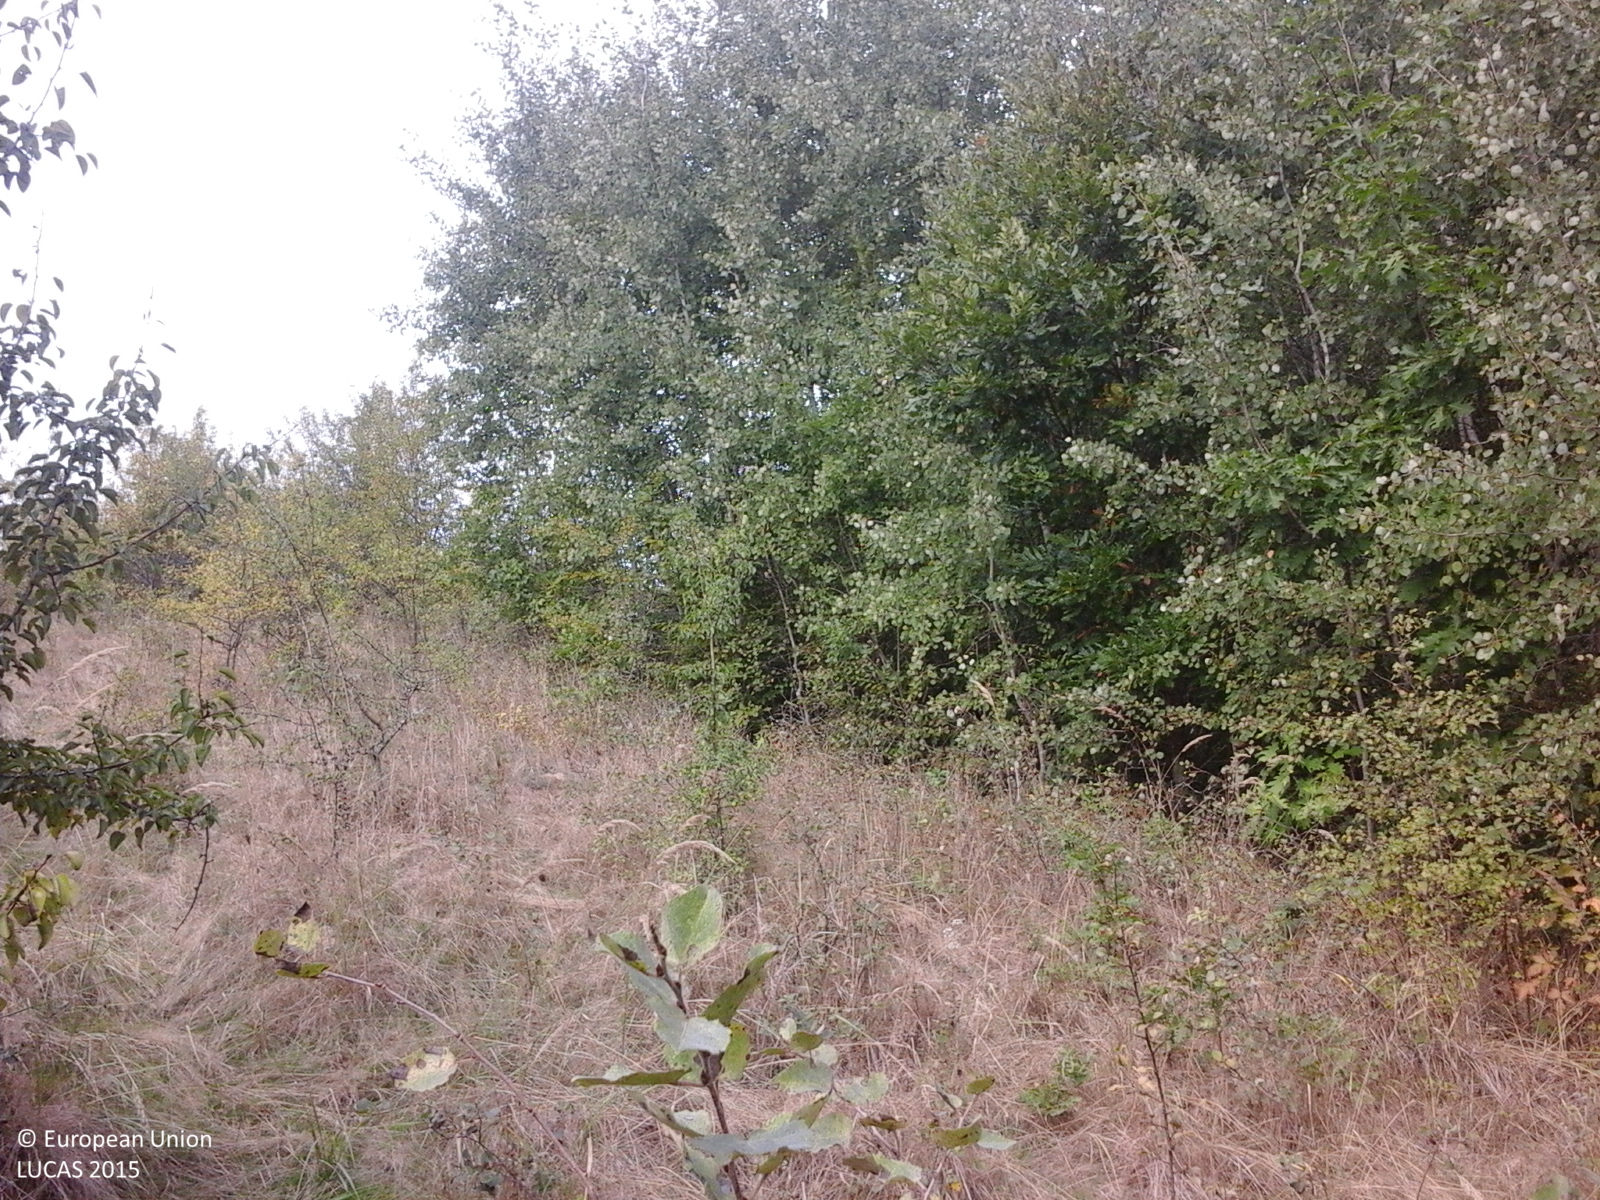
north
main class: Grassland
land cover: Grassland with sparse tree/shrub cover
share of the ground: > 75 %
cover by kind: herbaceous plants 85 %, shrubs 10 %, broadleaved forest trees 5 %
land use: Semi-natural and natural areas not in use
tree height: > 5 m
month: September
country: RO
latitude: 45.9462
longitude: 22.1564
